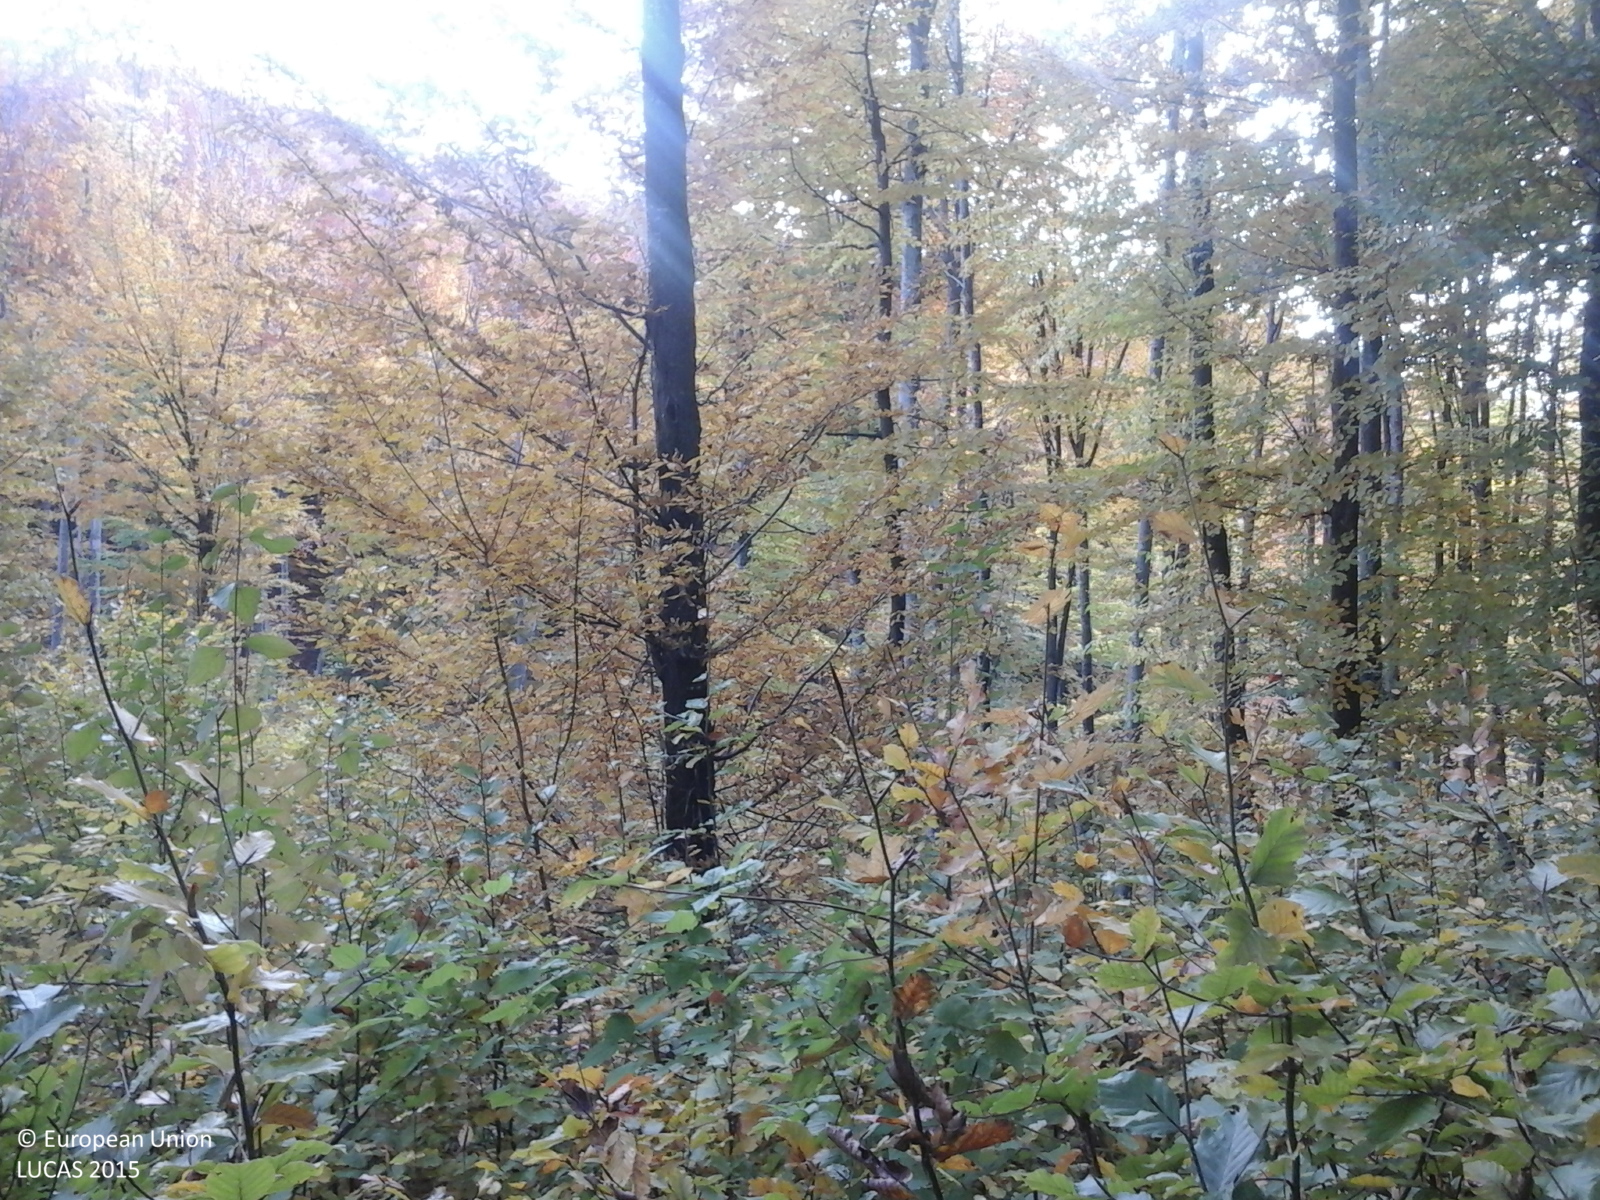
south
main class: Woodland
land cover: Broadleaved woodland
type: beech forest
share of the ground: > 75 %
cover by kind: broadleaved forest trees 100 %
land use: Forestry
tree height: > 5 m
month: October
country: RO
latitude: 45.5304
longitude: 26.7660
